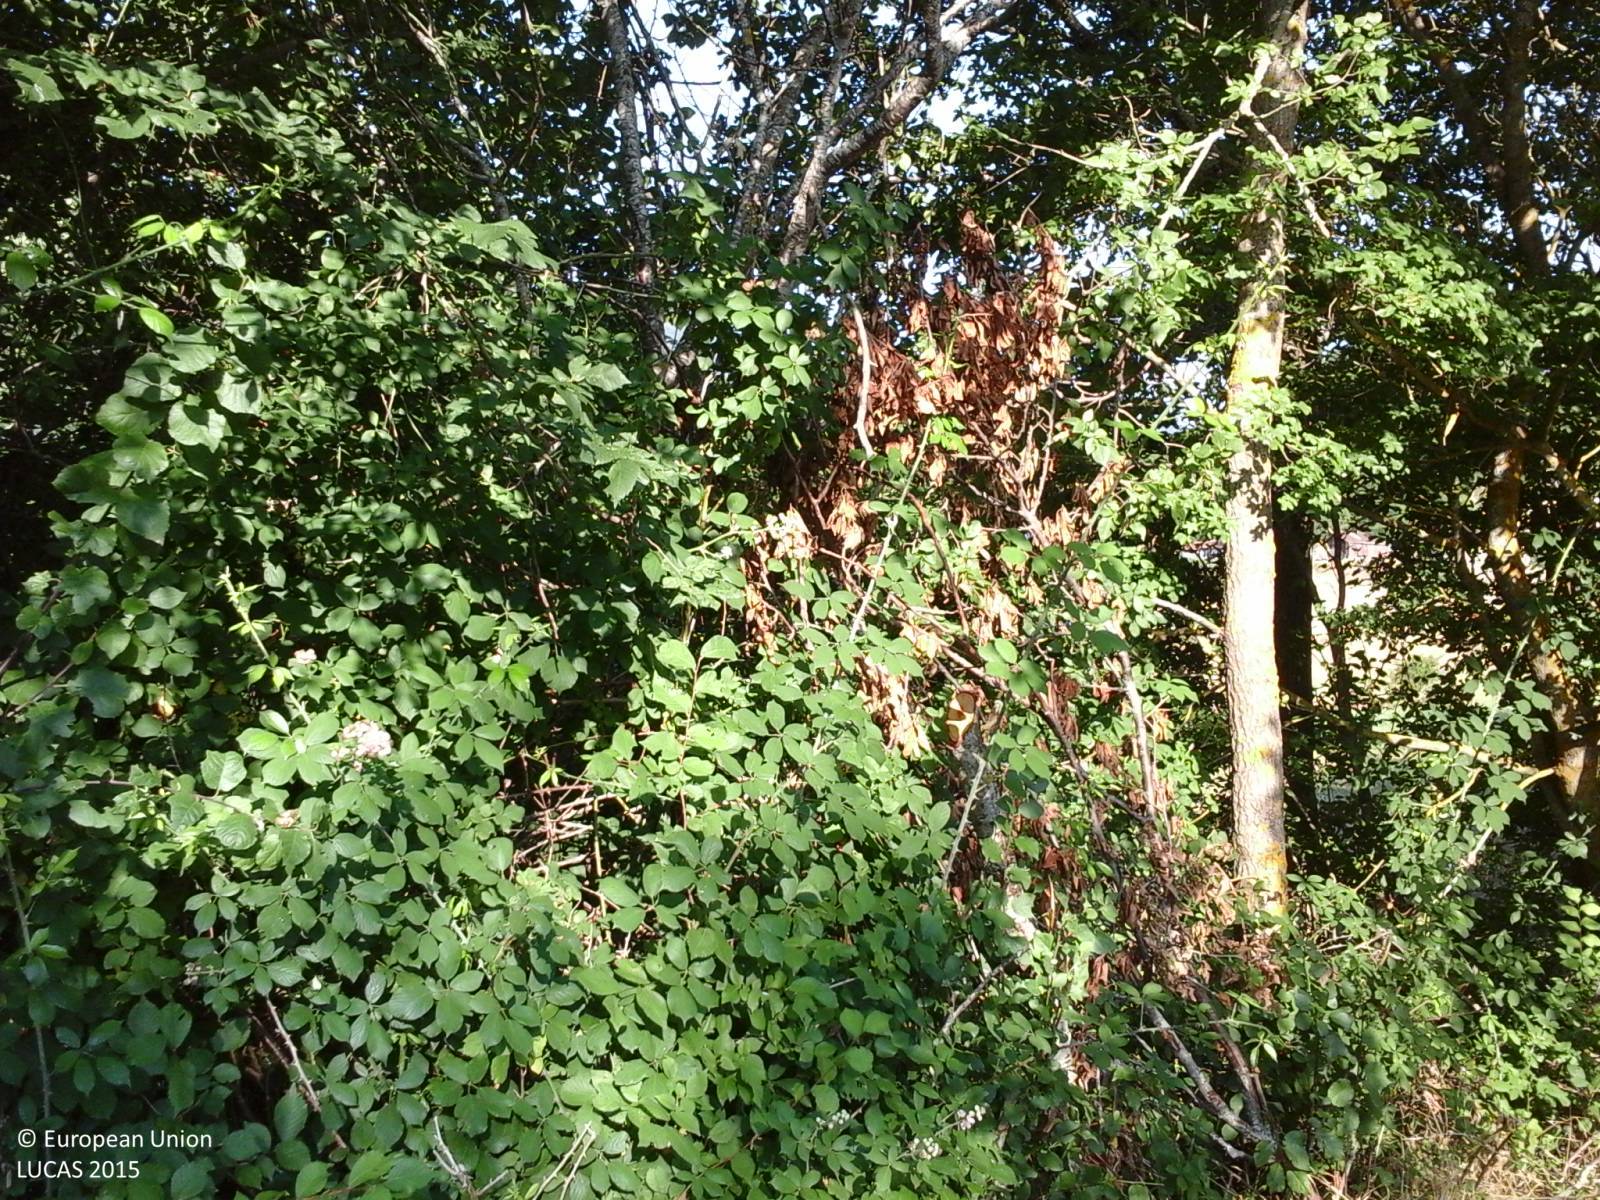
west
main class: Grassland
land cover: Spontaneously vegetated surfaces
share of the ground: > 75 %
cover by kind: herbaceous plants 100 %
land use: Agriculture (excluding fallow land and kitchen gardens)
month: July
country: IT
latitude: 42.3690
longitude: 13.1833
